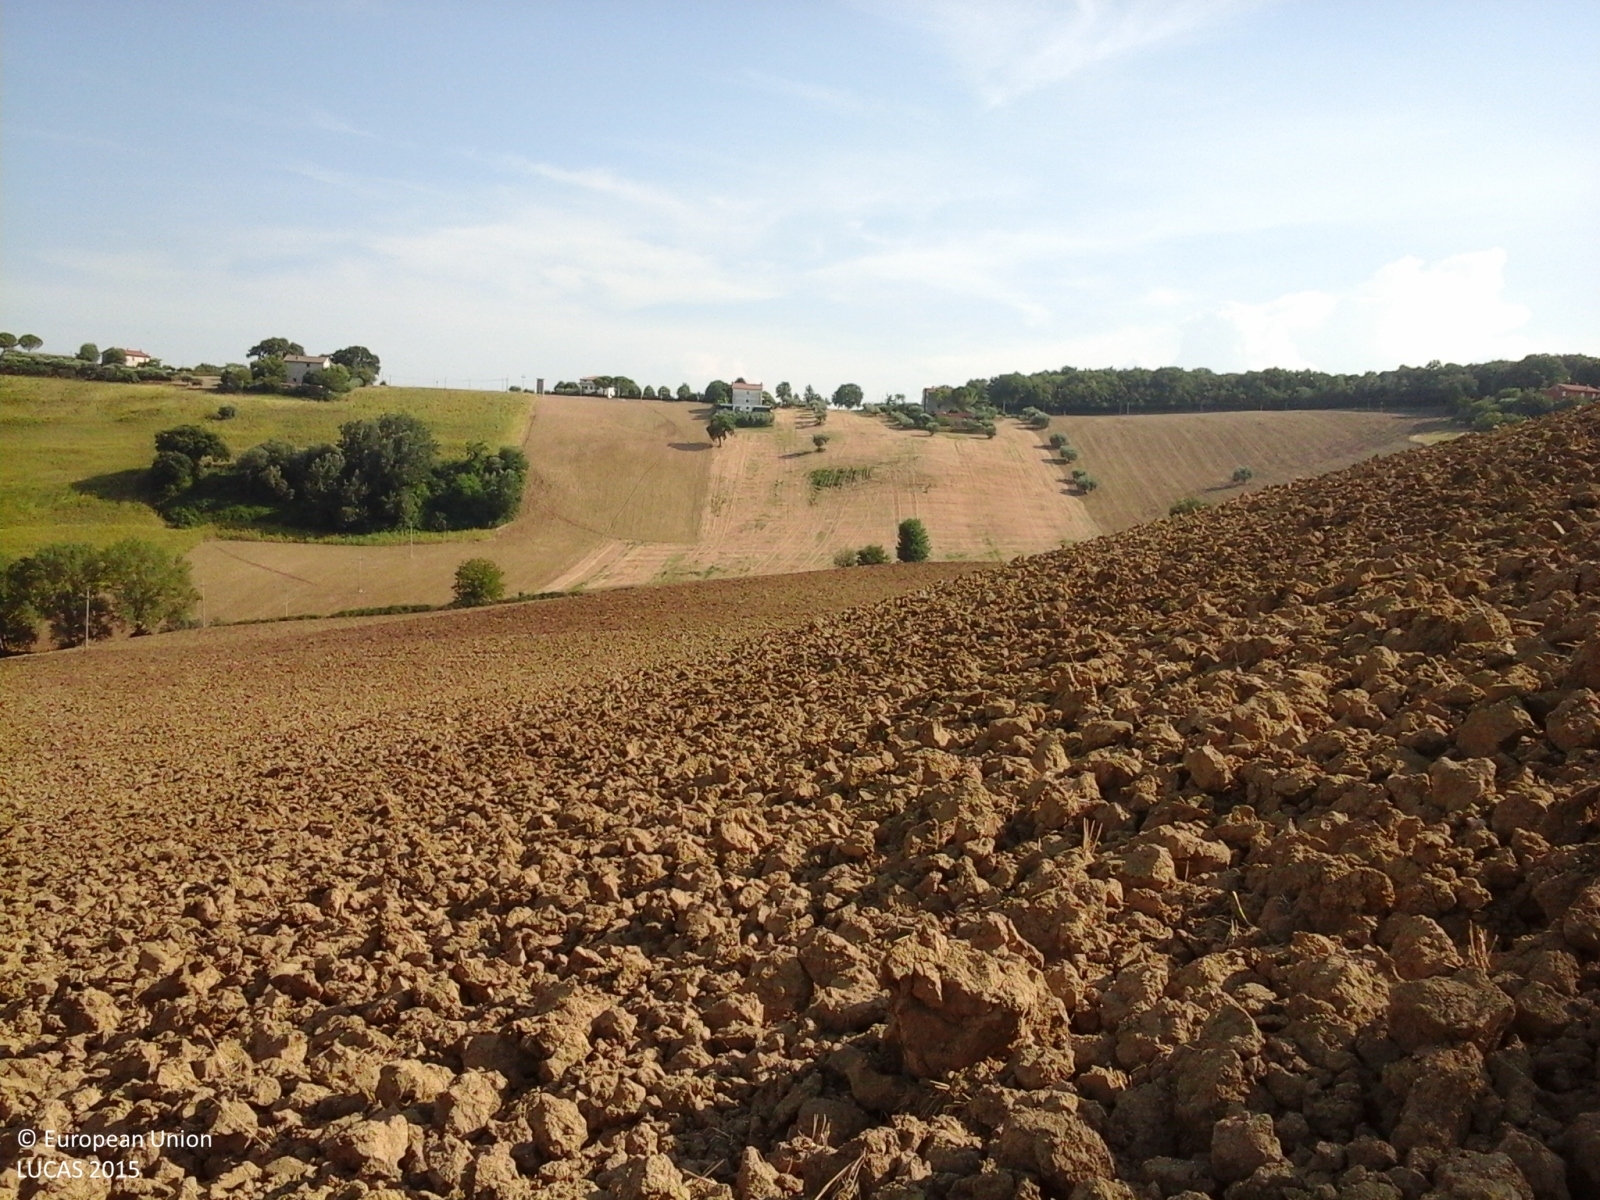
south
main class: Cropland
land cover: Durum wheat
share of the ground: < 10 %
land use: Agriculture (excluding fallow land and kitchen gardens)
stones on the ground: 10 - 25 %
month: August
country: IT
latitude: 43.4466
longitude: 13.3896
